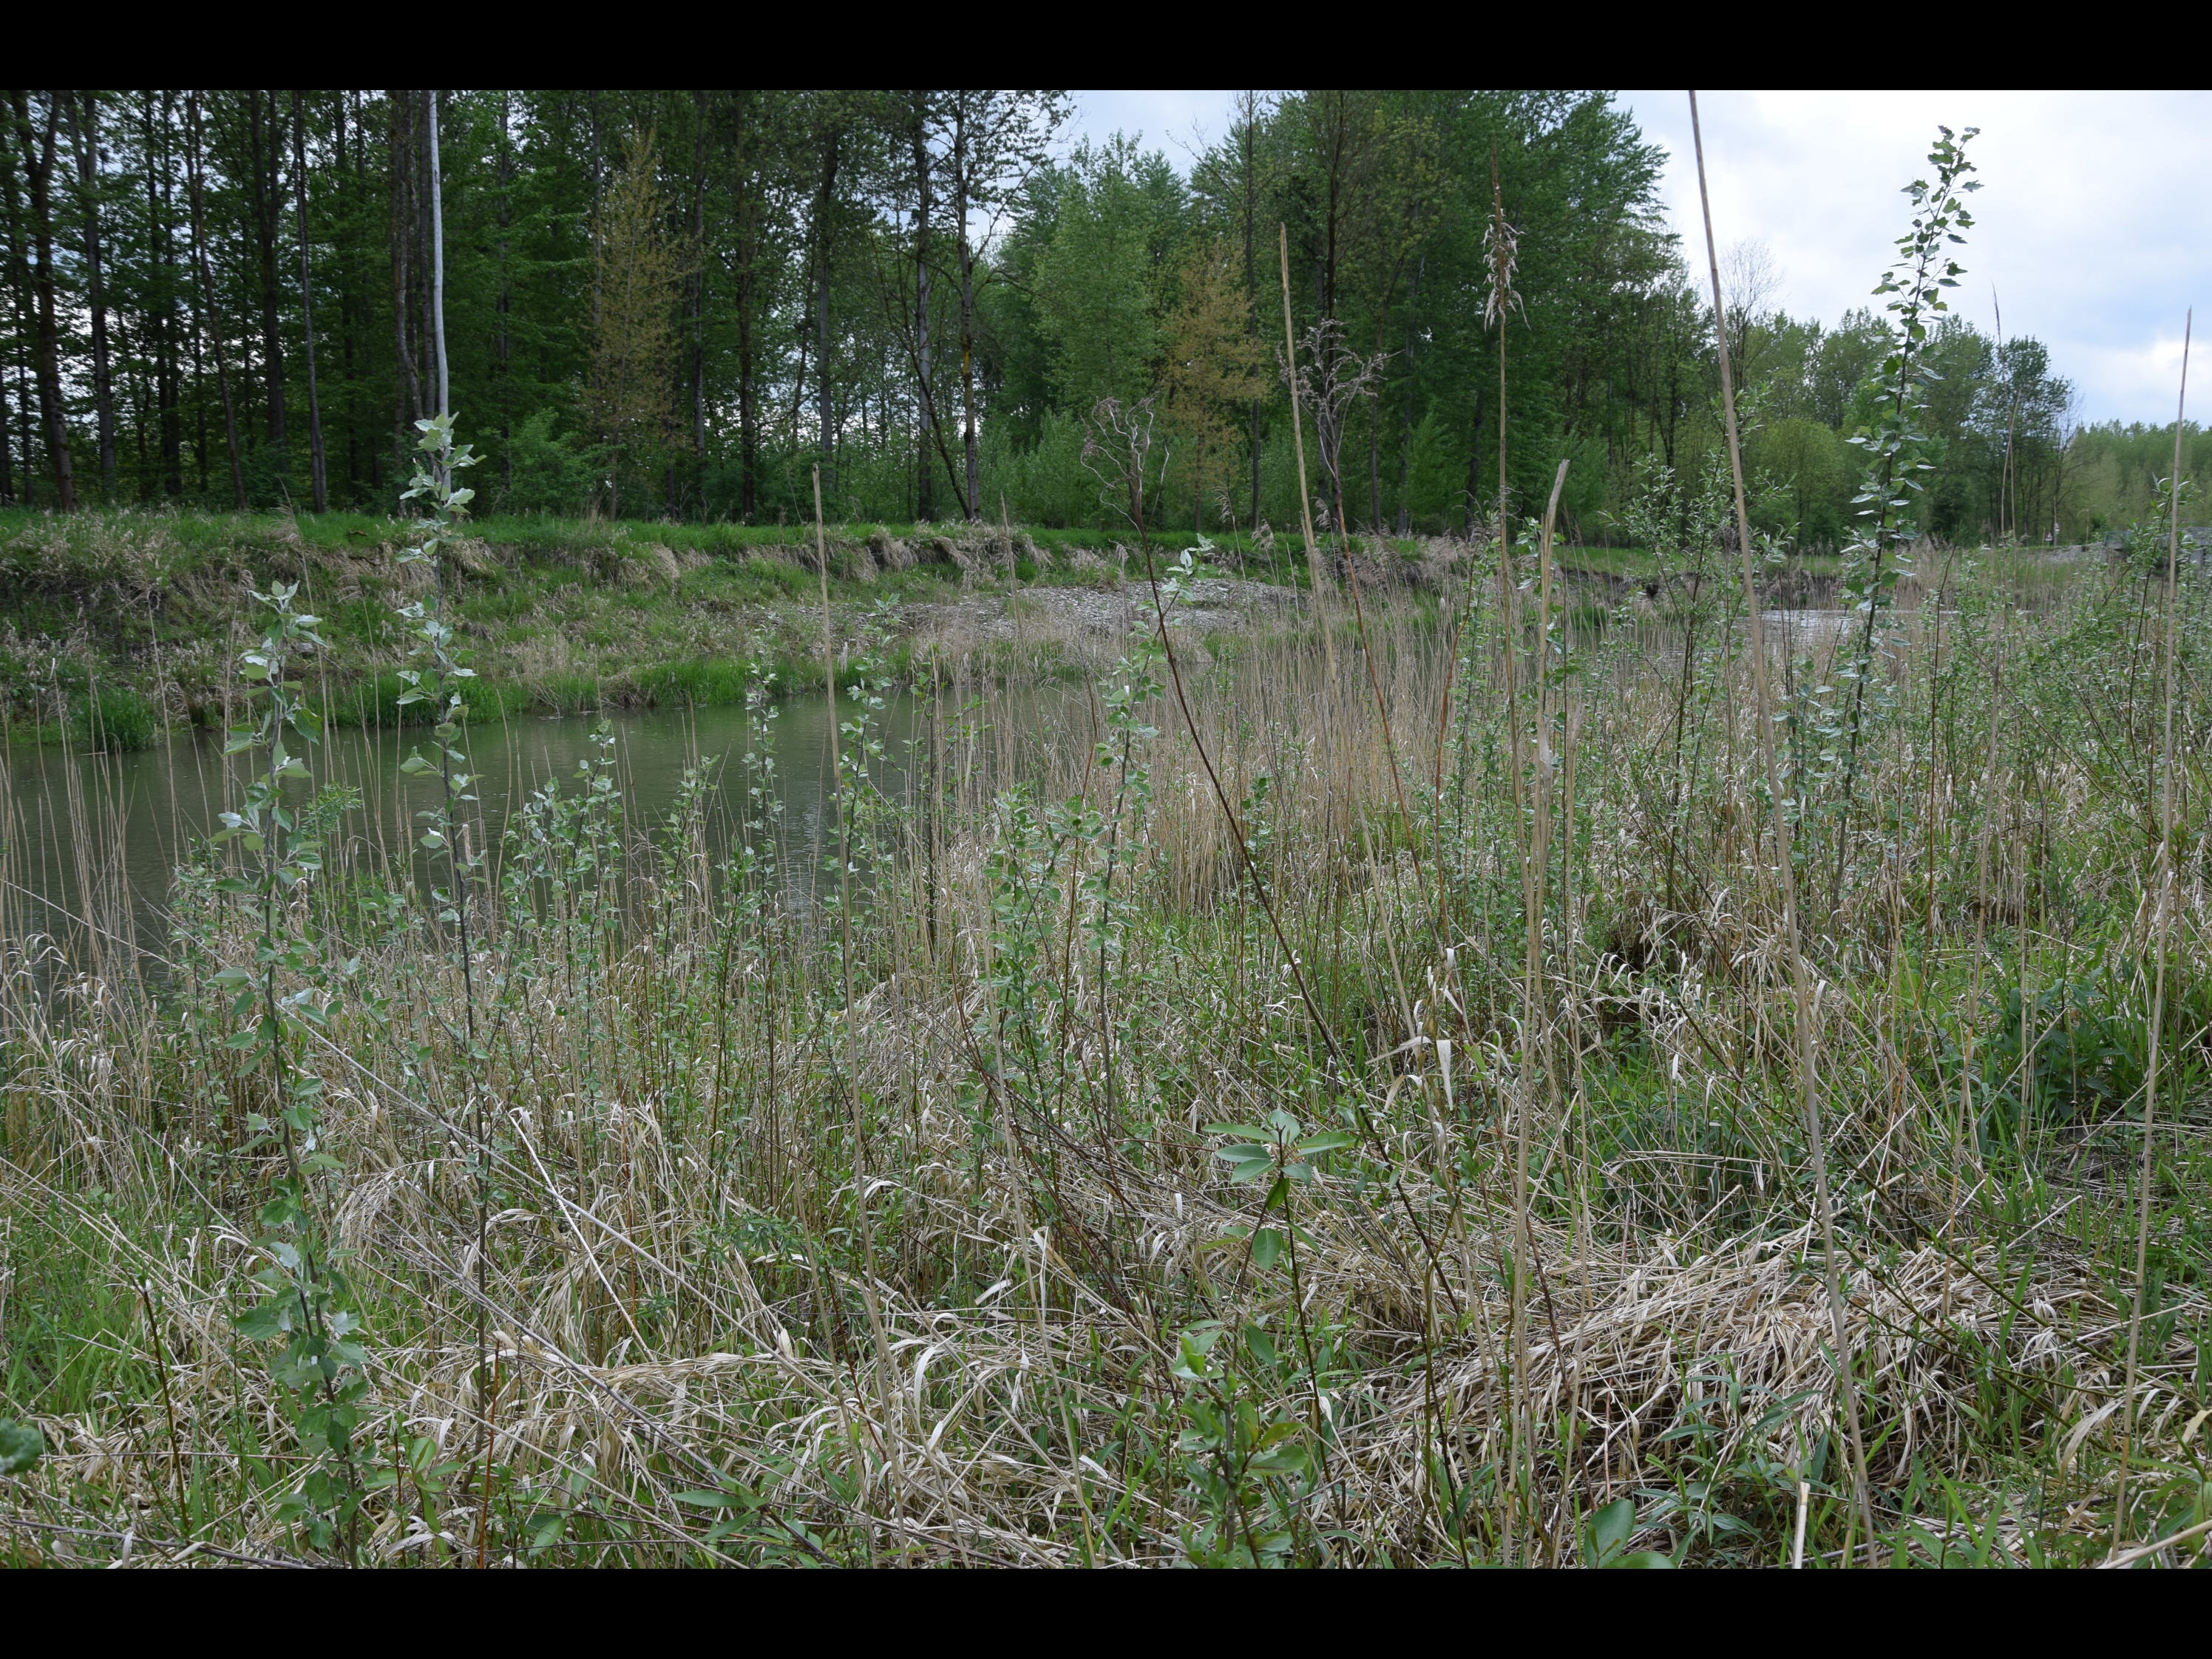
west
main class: Shrubland
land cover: Shrubland with sparse tree cover
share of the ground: > 75 %
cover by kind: herbaceous plants 80 %, shrubs 15 %, broadleaved forest trees 5 %
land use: Semi-natural and natural areas not in use
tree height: < 5 m
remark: Temporary flooded
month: May
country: AT
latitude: 48.1990
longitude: 14.6153
